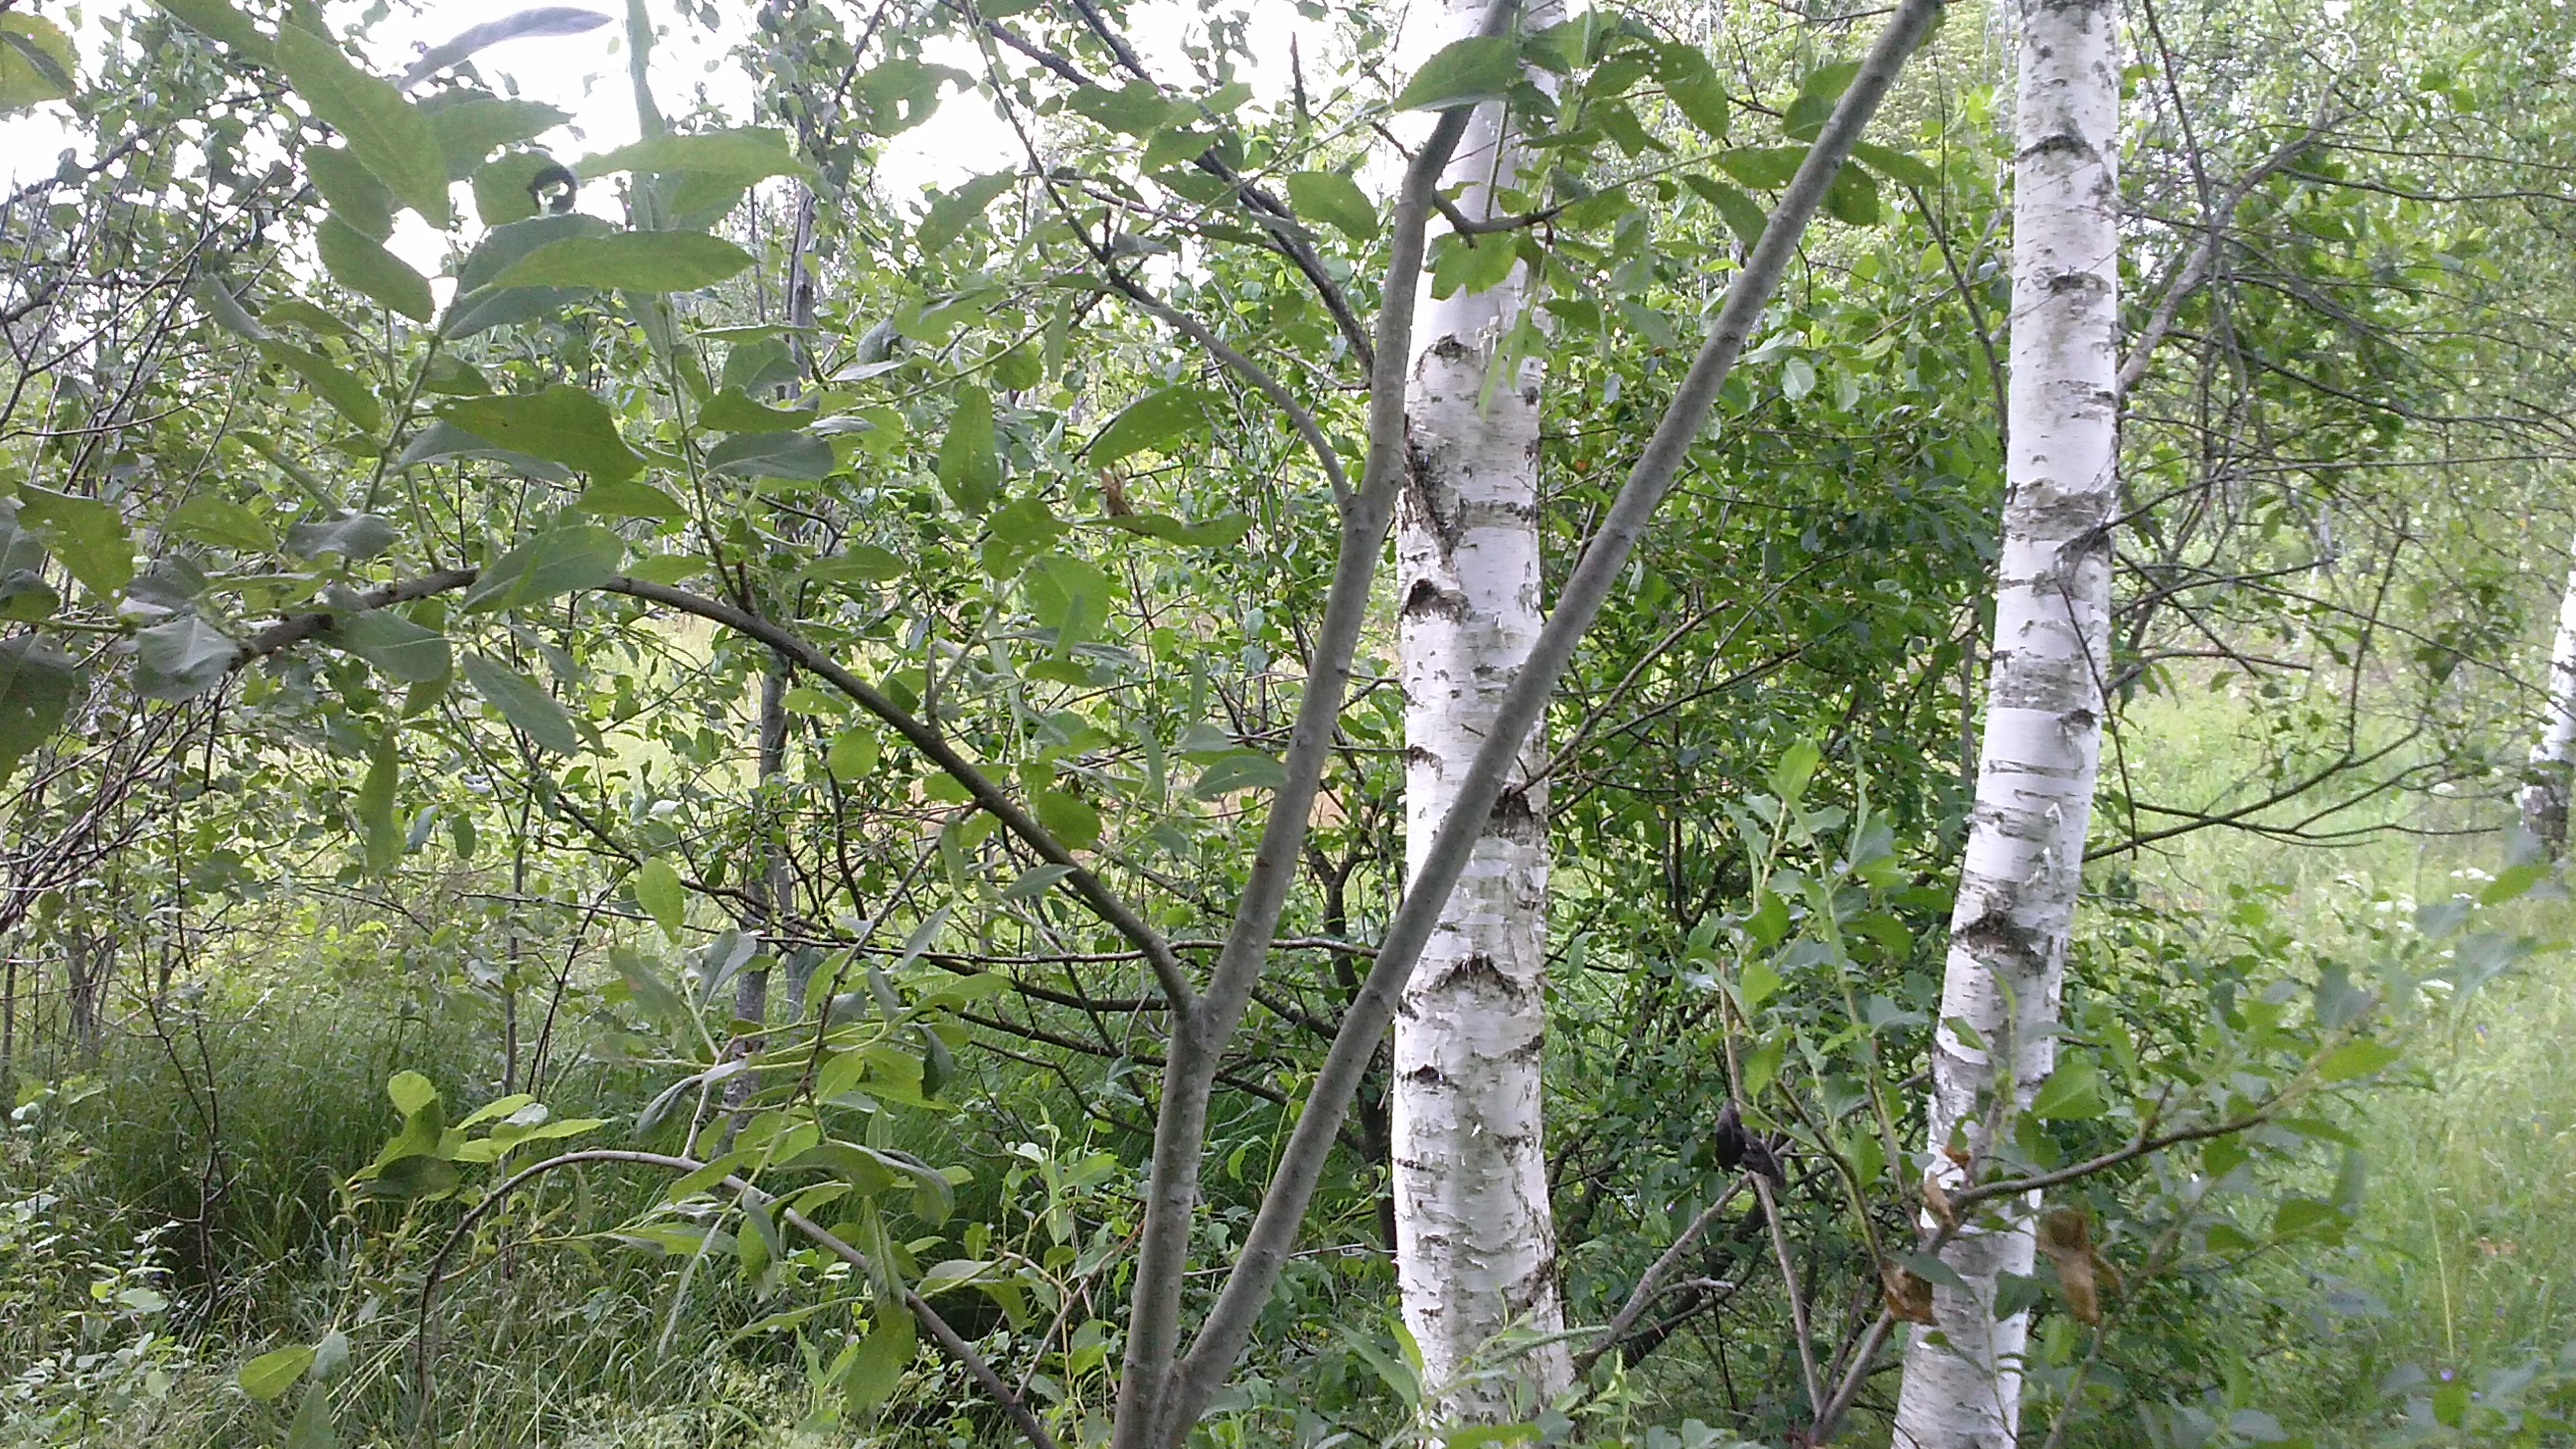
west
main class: Woodland
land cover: Broadleaved woodland
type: non-riverine alder, birch or aspen forest
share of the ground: 50 - 75 %
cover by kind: broadleaved forest trees 65 %, herbaceous plants 30 %, coniferous forest trees 5 %
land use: Forestry
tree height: > 5 m
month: July
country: LV
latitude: 56.5614
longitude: 27.4749
